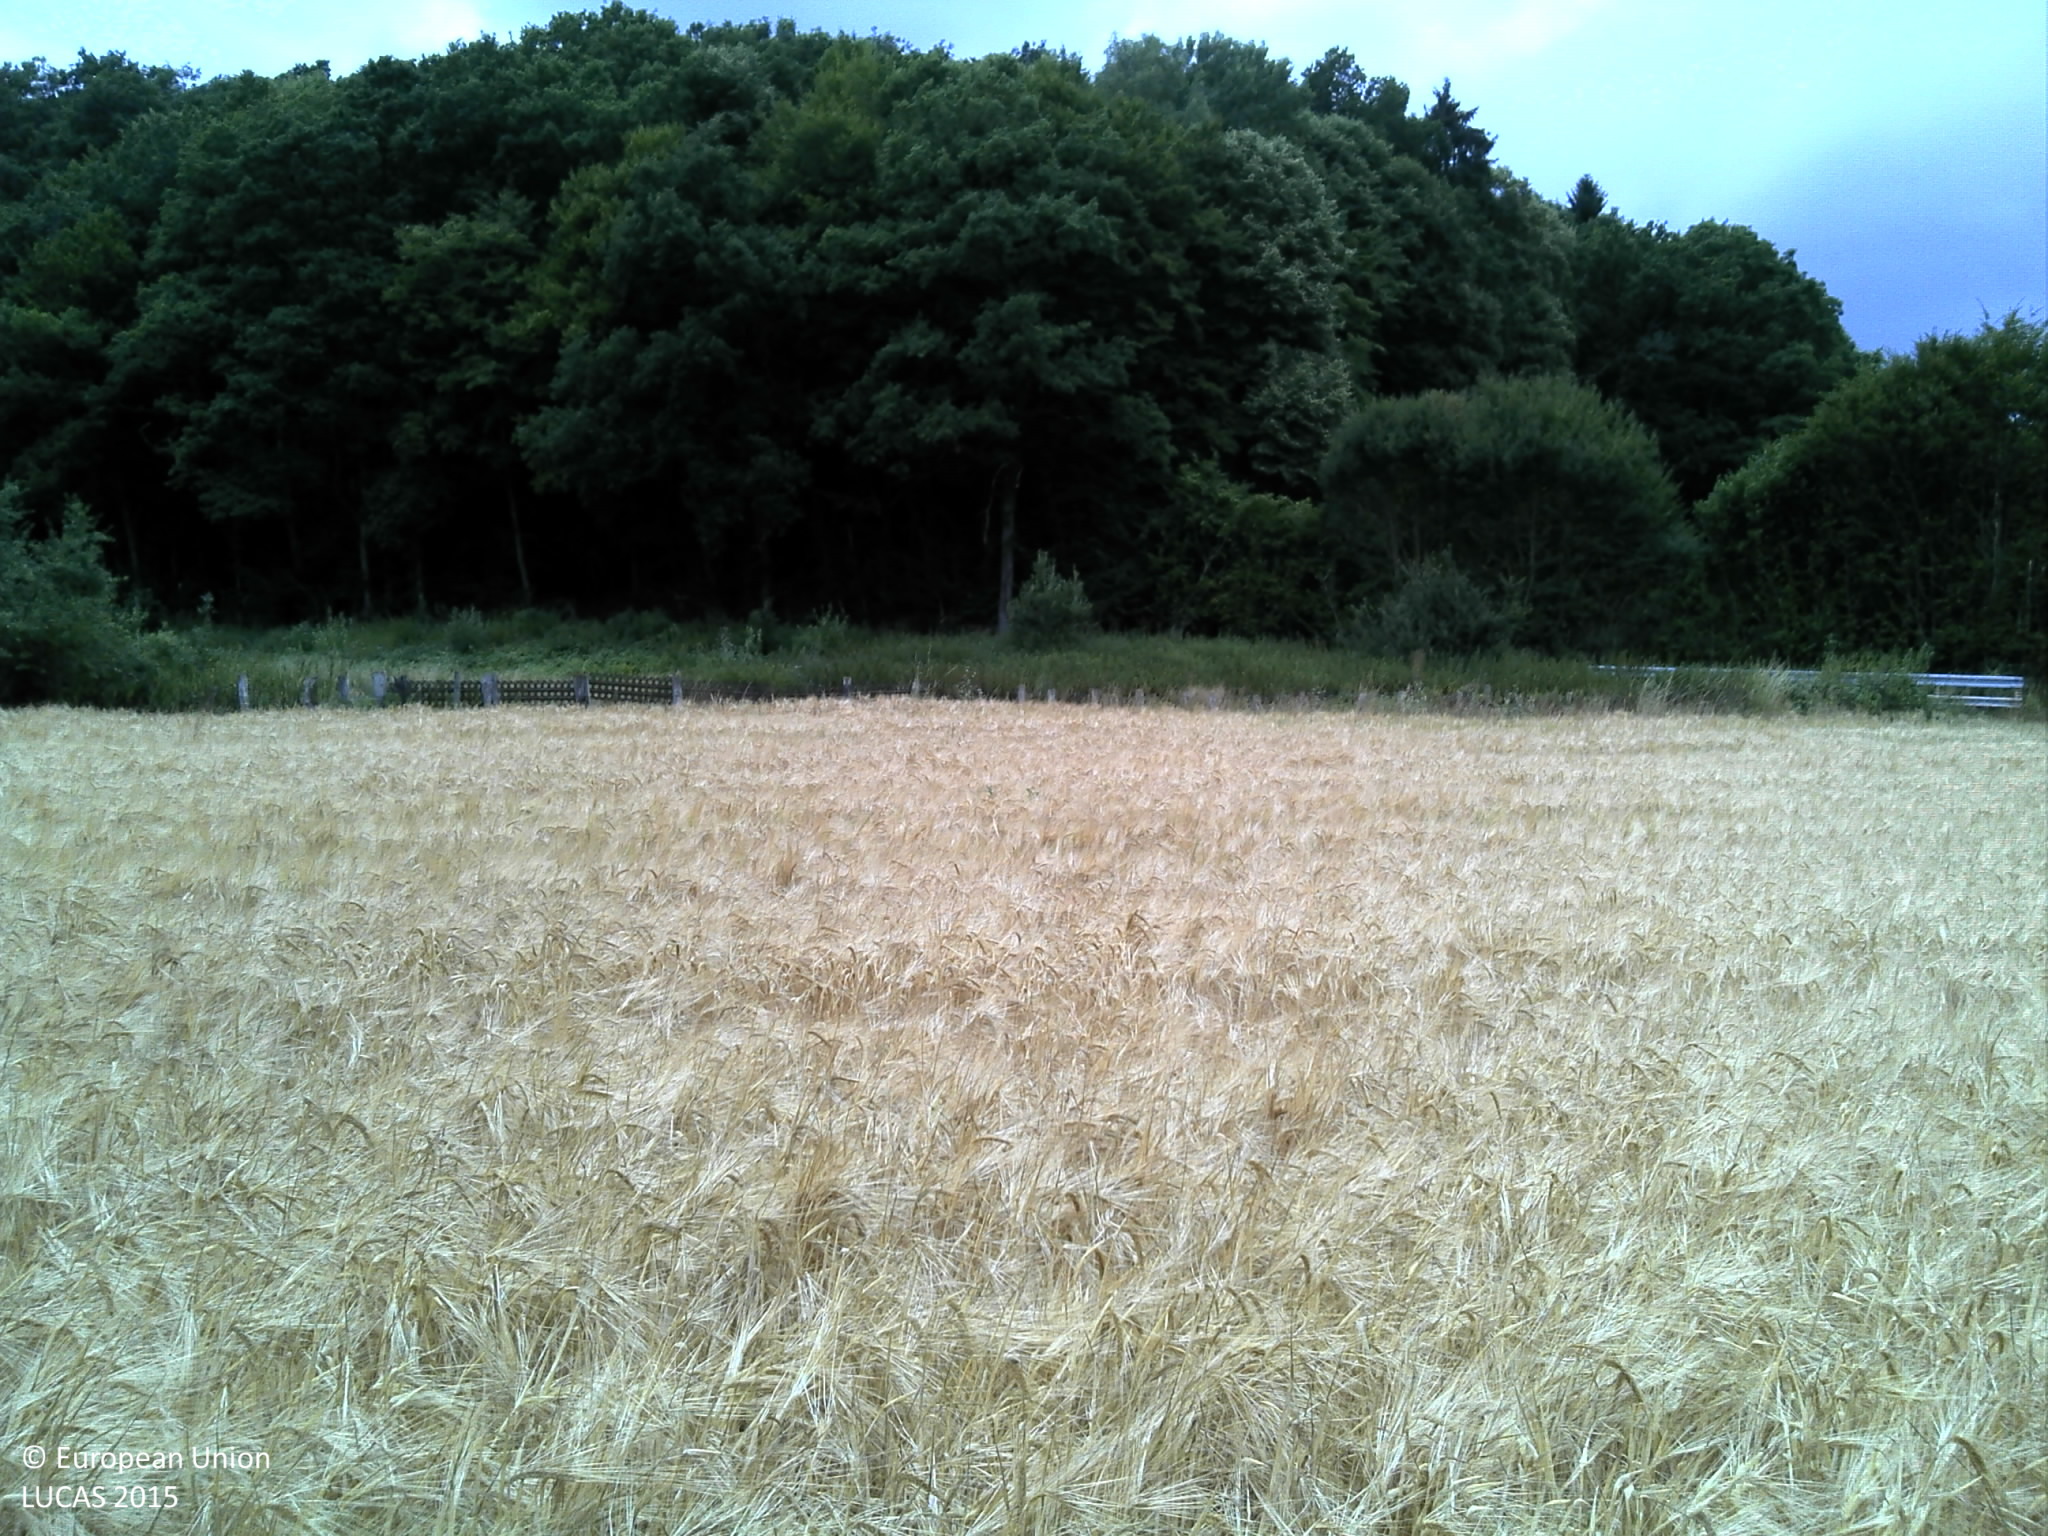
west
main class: Cropland
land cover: Rye
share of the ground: > 75 %
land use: Agriculture (excluding fallow land and kitchen gardens)
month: July
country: FR
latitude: 49.1862
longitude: 4.8798
